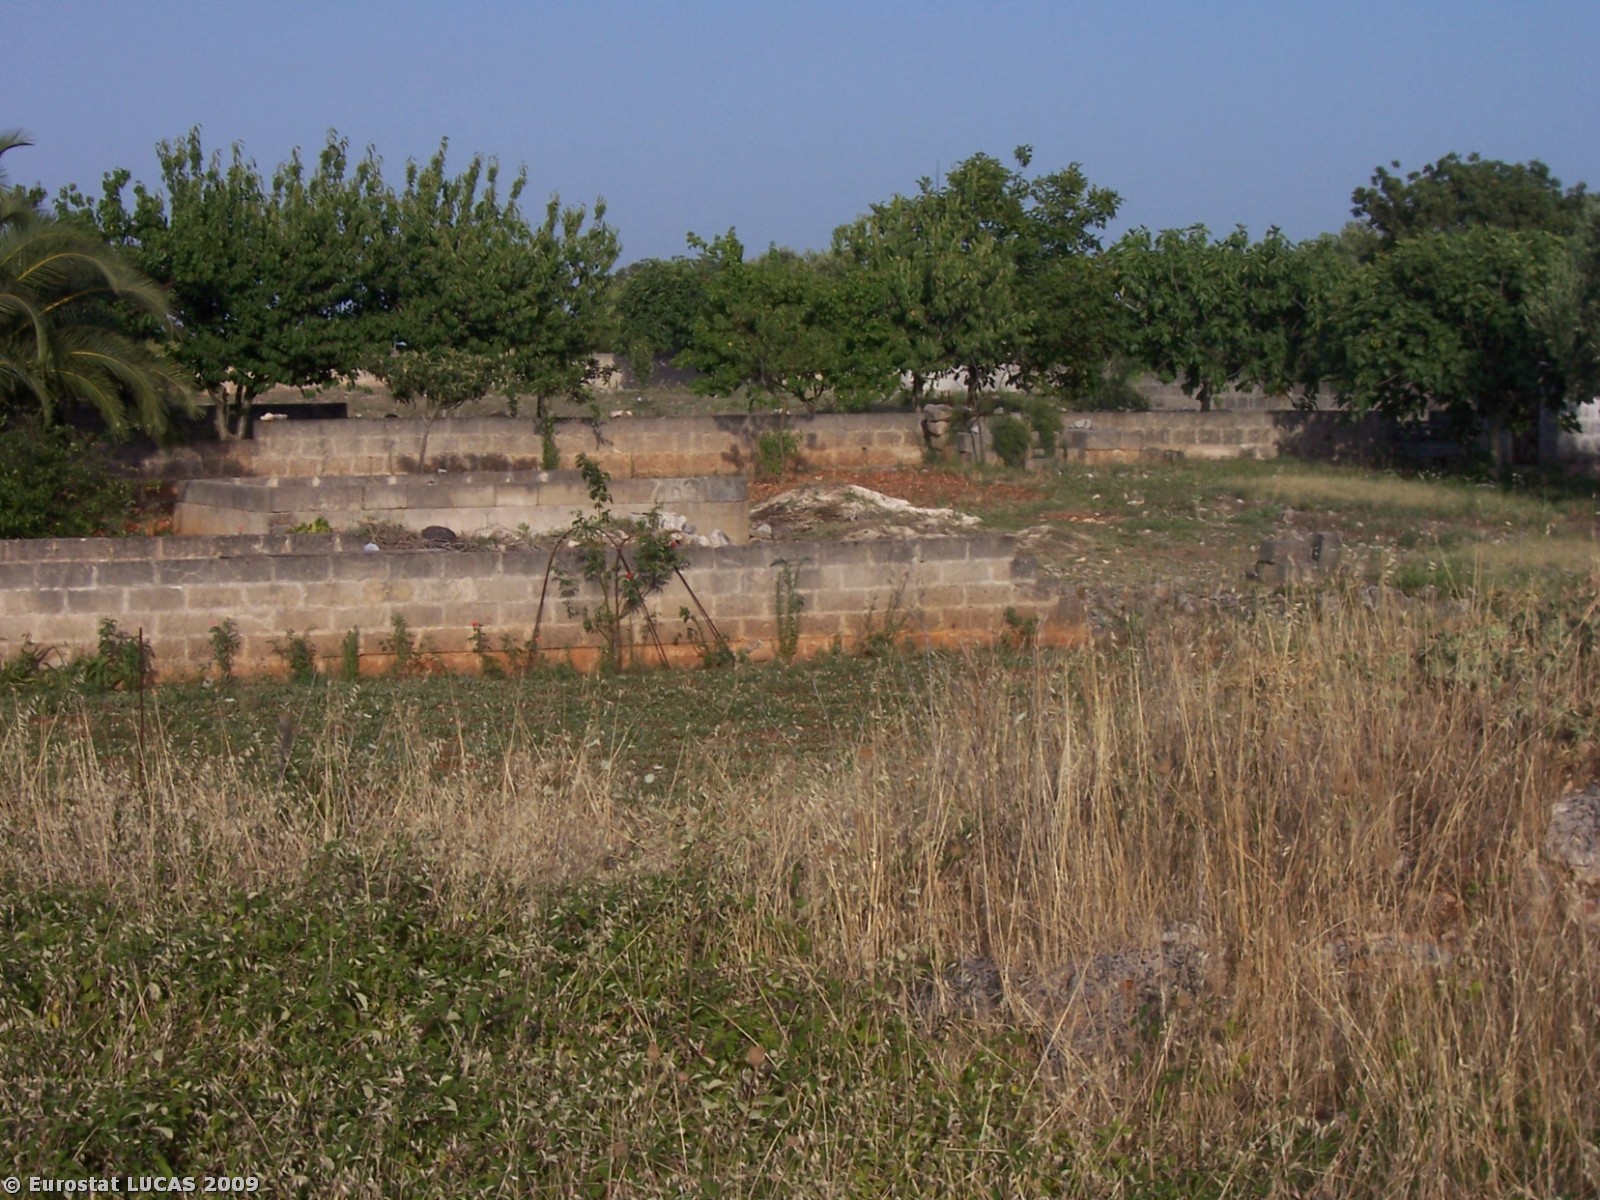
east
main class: Grassland
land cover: Spontaneously vegetated surfaces
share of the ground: > 75 %
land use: Fallow land
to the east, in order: Spontaneously vegetated surfaces; Dry stone walls; Bare land; Dry stone walls; Bare land; Olive groves; Bare land; Dry stone walls; Grassland with sparse tree/shrub cover; Spontaneously vegetated surfaces; Dry stone walls; Broadleaved woodland
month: July
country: IT
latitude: 40.6494
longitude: 17.5336
